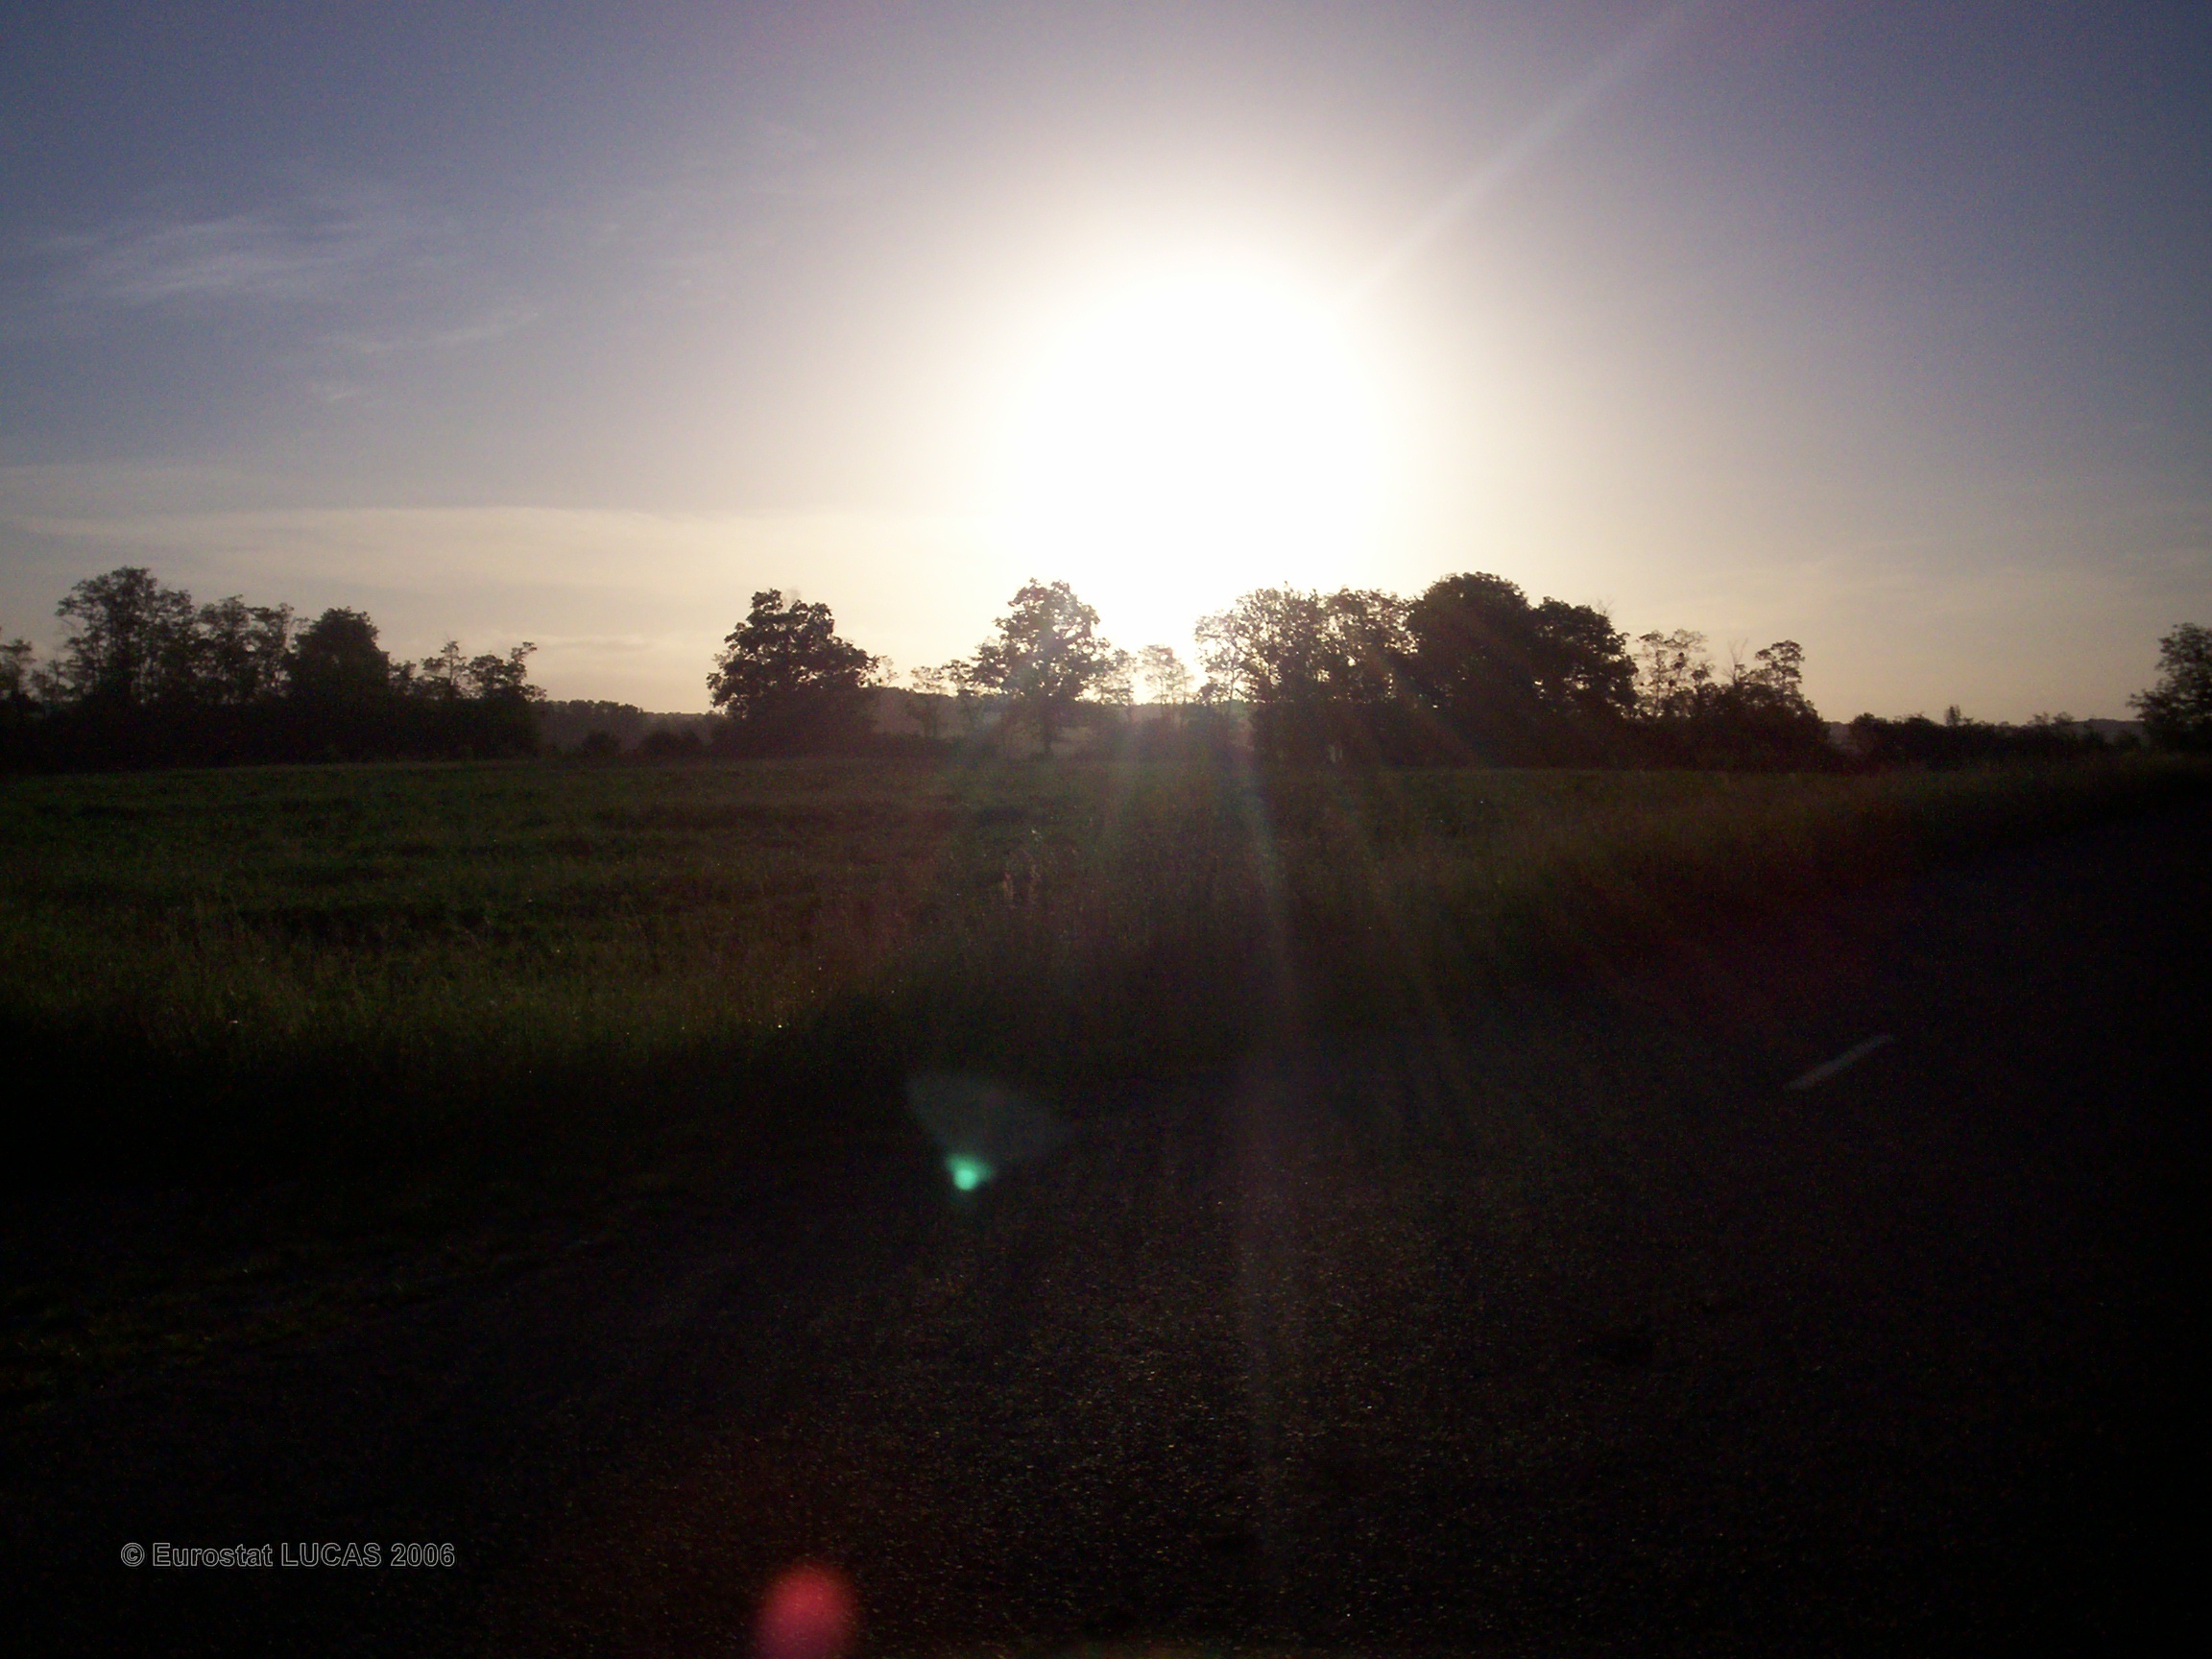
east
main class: Cropland
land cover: Rape and turnip rape
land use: Agriculture (excluding fallow land and kitchen gardens)
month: May
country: FR
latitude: 47.3494
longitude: 5.3280
